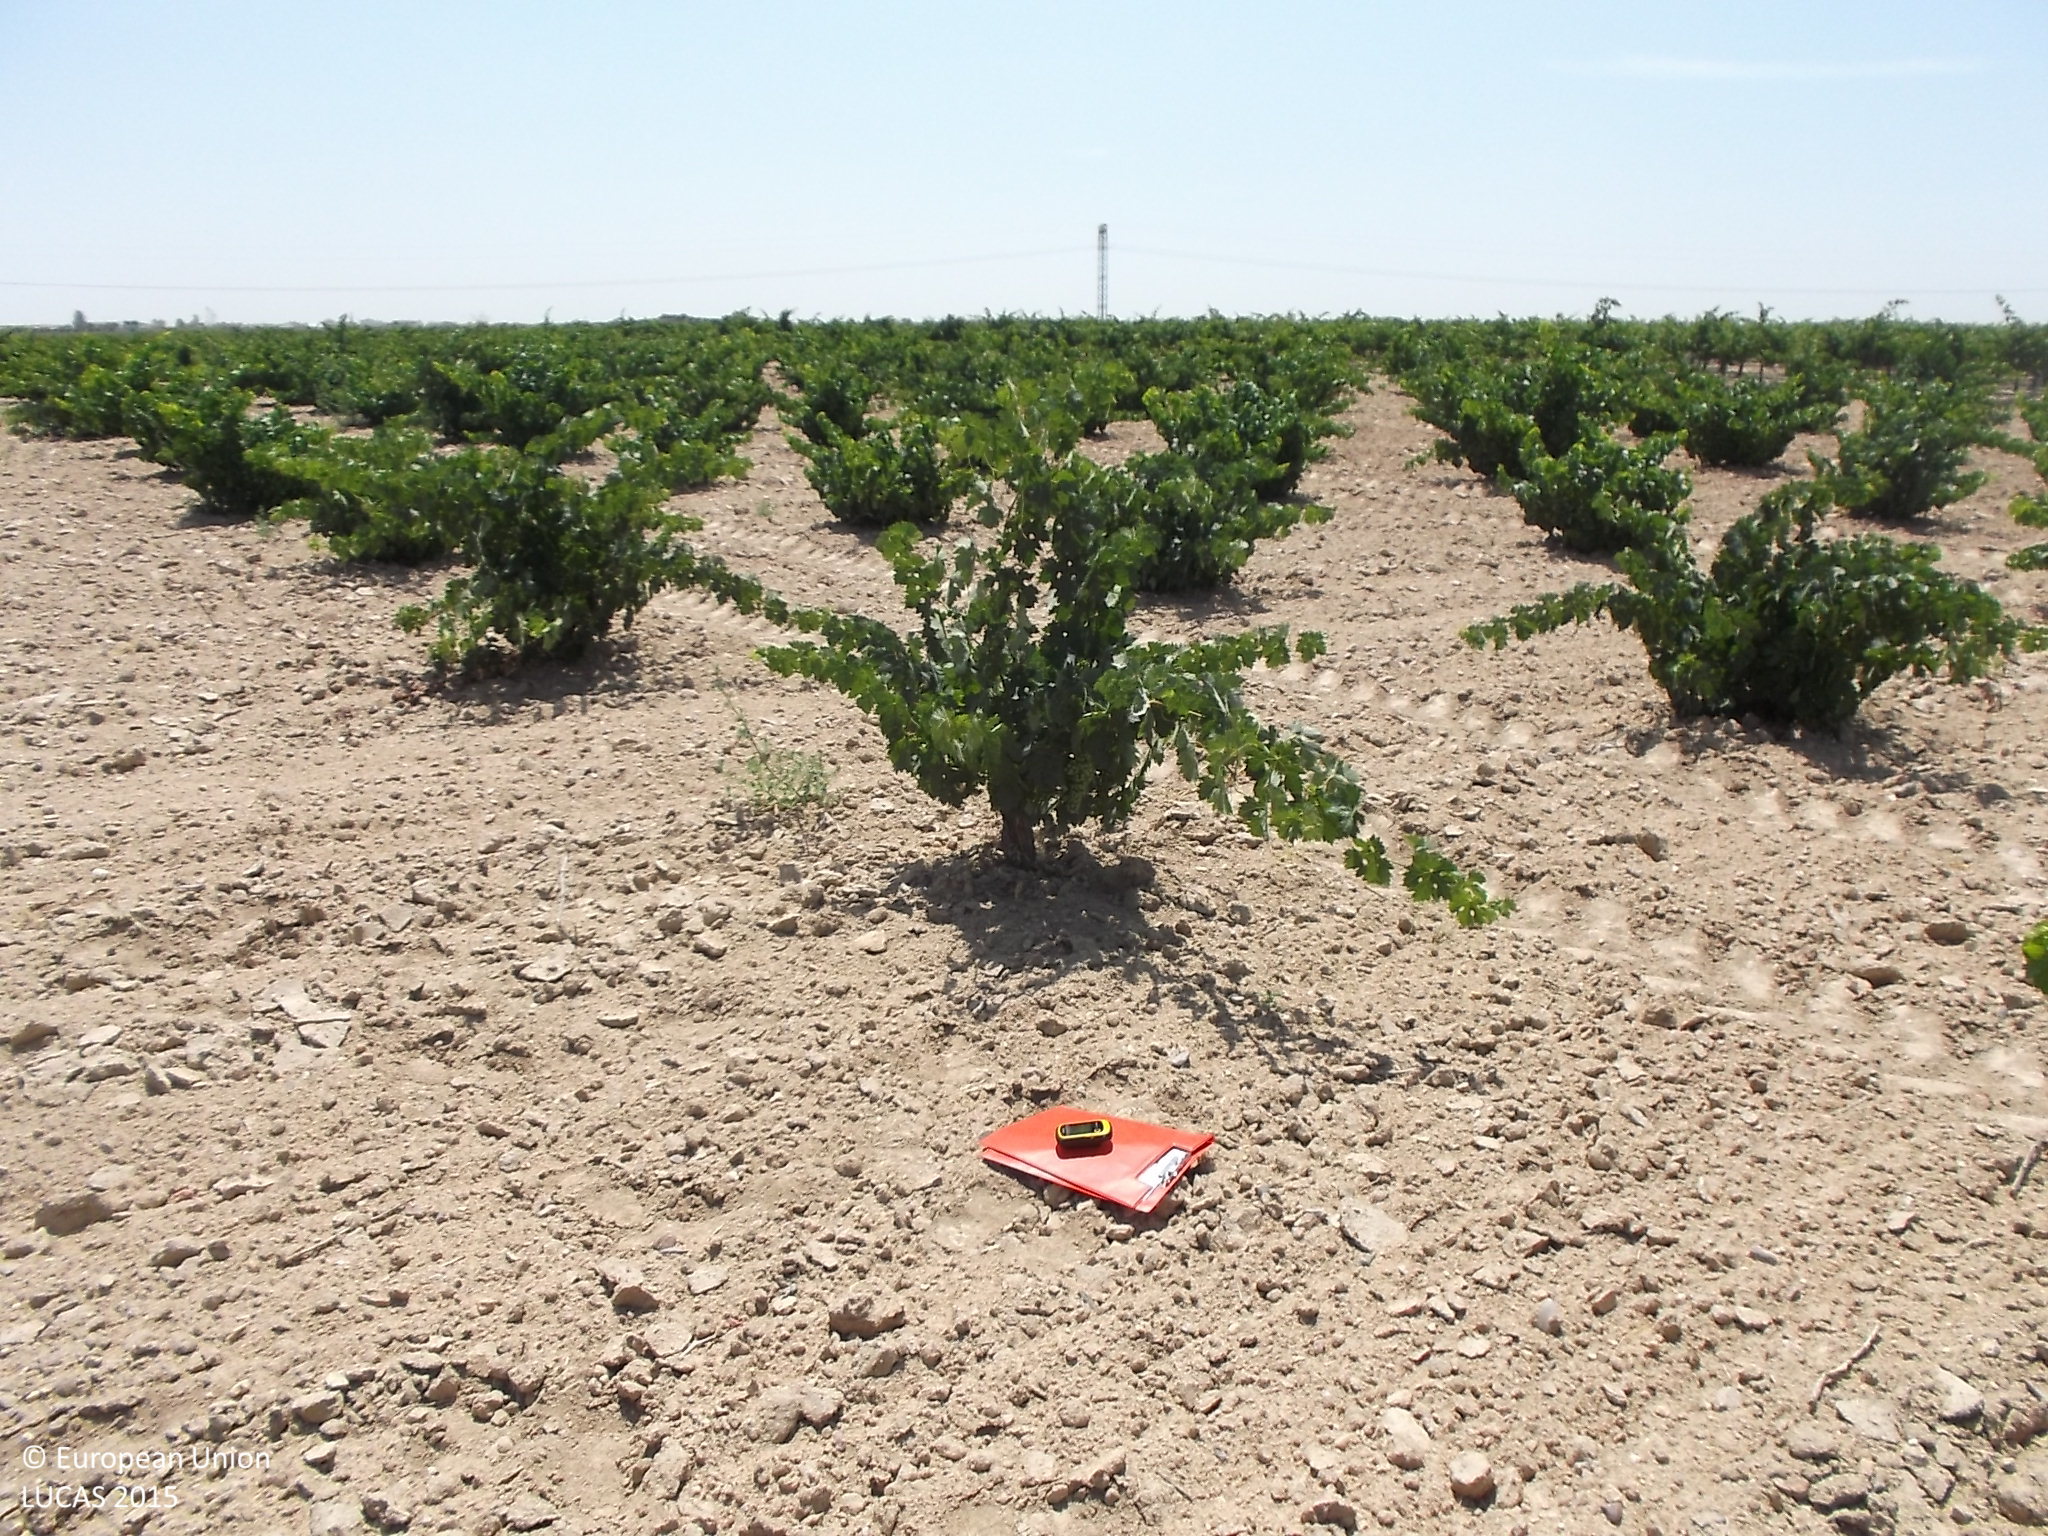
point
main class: Cropland
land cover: Vineyards
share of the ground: 10 - 25 %
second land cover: Other bare soil
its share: > 75 %
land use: Agriculture (excluding fallow land and kitchen gardens)
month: July
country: ES
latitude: 41.5544
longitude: -5.3173
